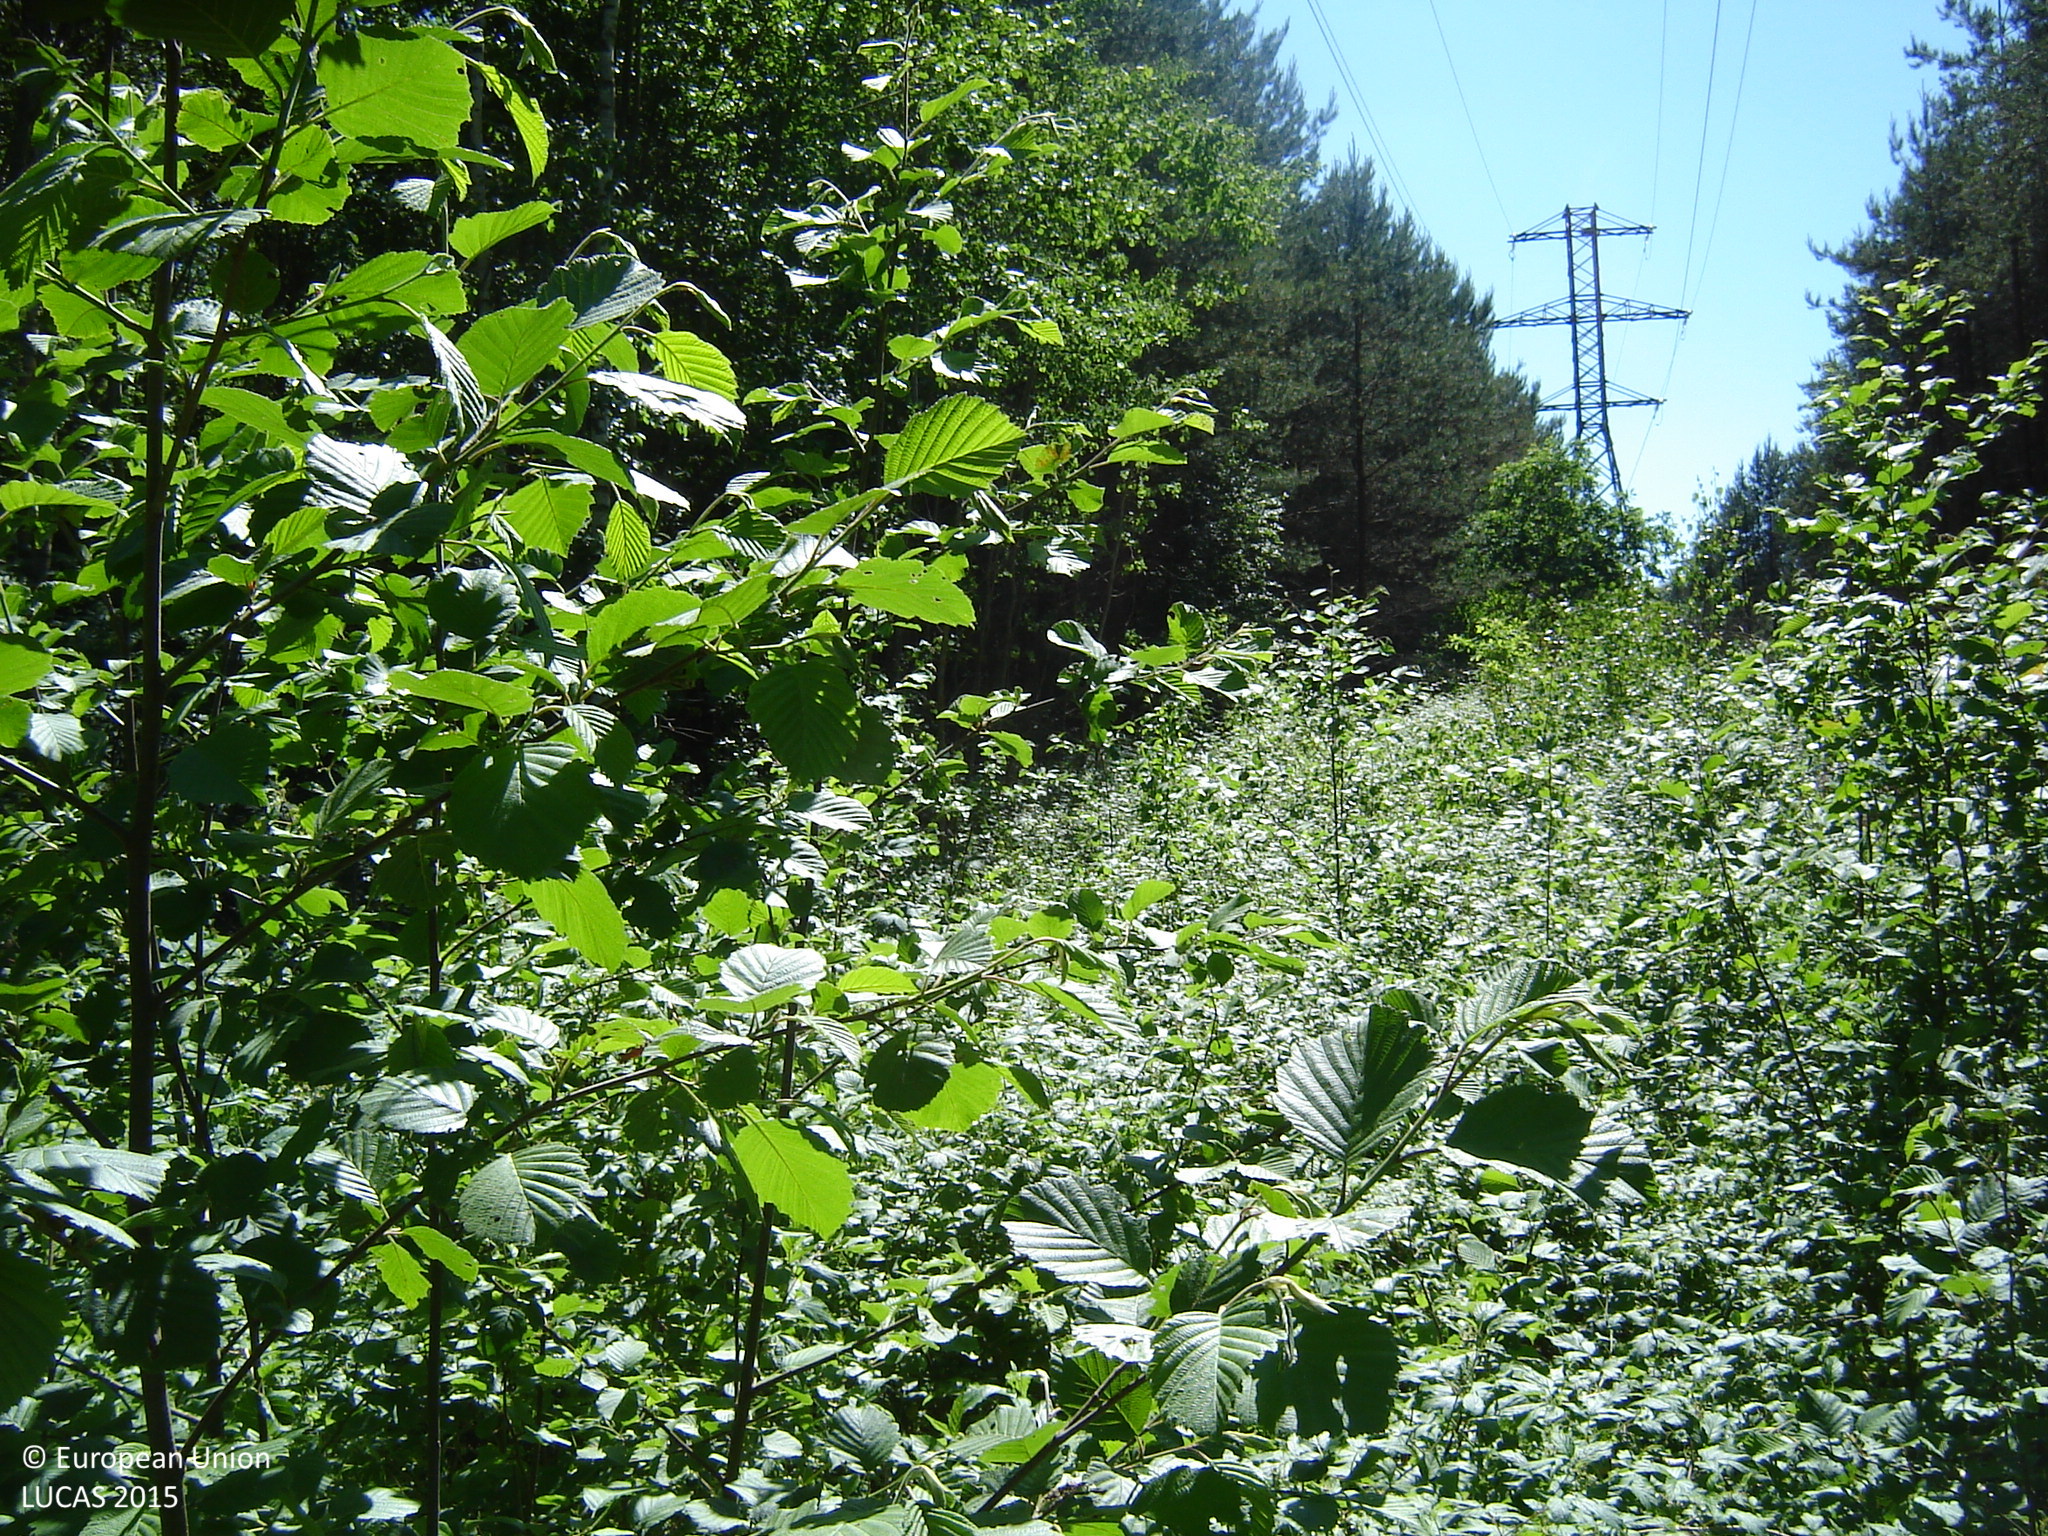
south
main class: Artificial land
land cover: Other artificial areas
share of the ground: > 75 %
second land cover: Spontaneously vegetated surfaces
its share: > 75 %
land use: Electricity, gas and thermal power distribution
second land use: Forestry
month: June
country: LT
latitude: 55.5656
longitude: 25.0664
